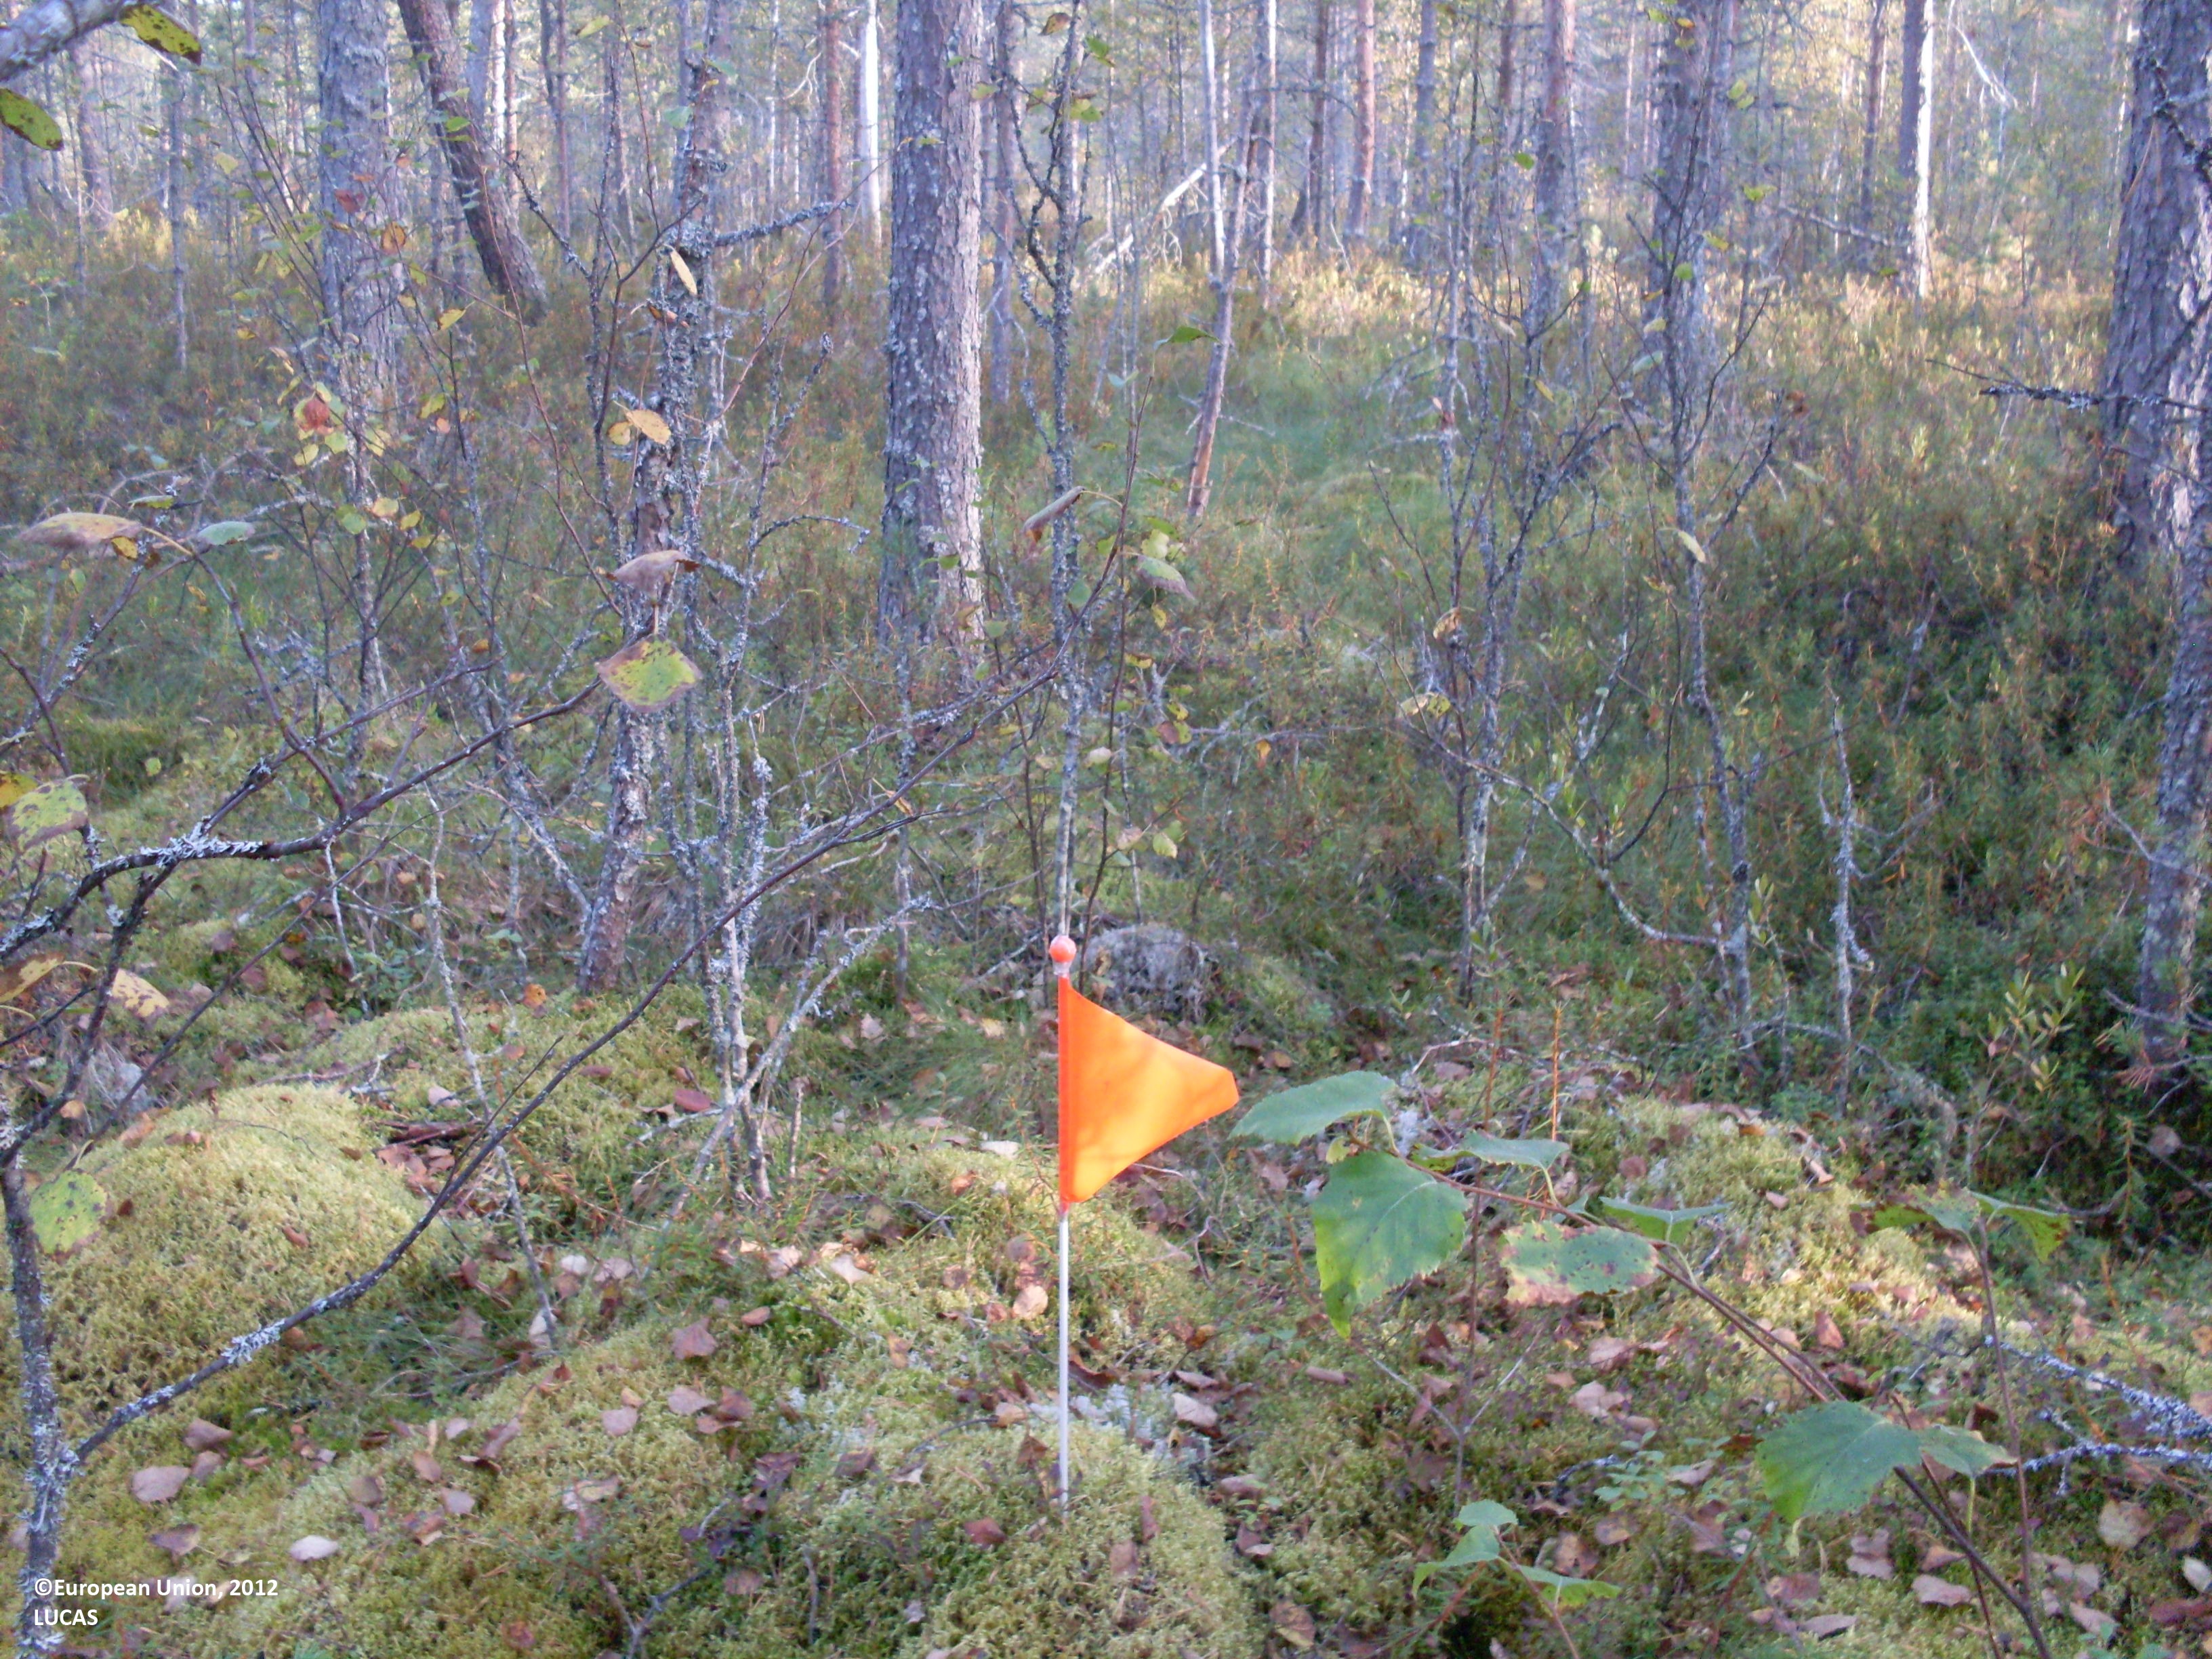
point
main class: Woodland
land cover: Pine dominated coniferous woodland
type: boreal forest
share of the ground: 50 - 75 %
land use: Forestry
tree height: > 5 m
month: September
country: FI
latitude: 64.0790
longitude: 29.2578
